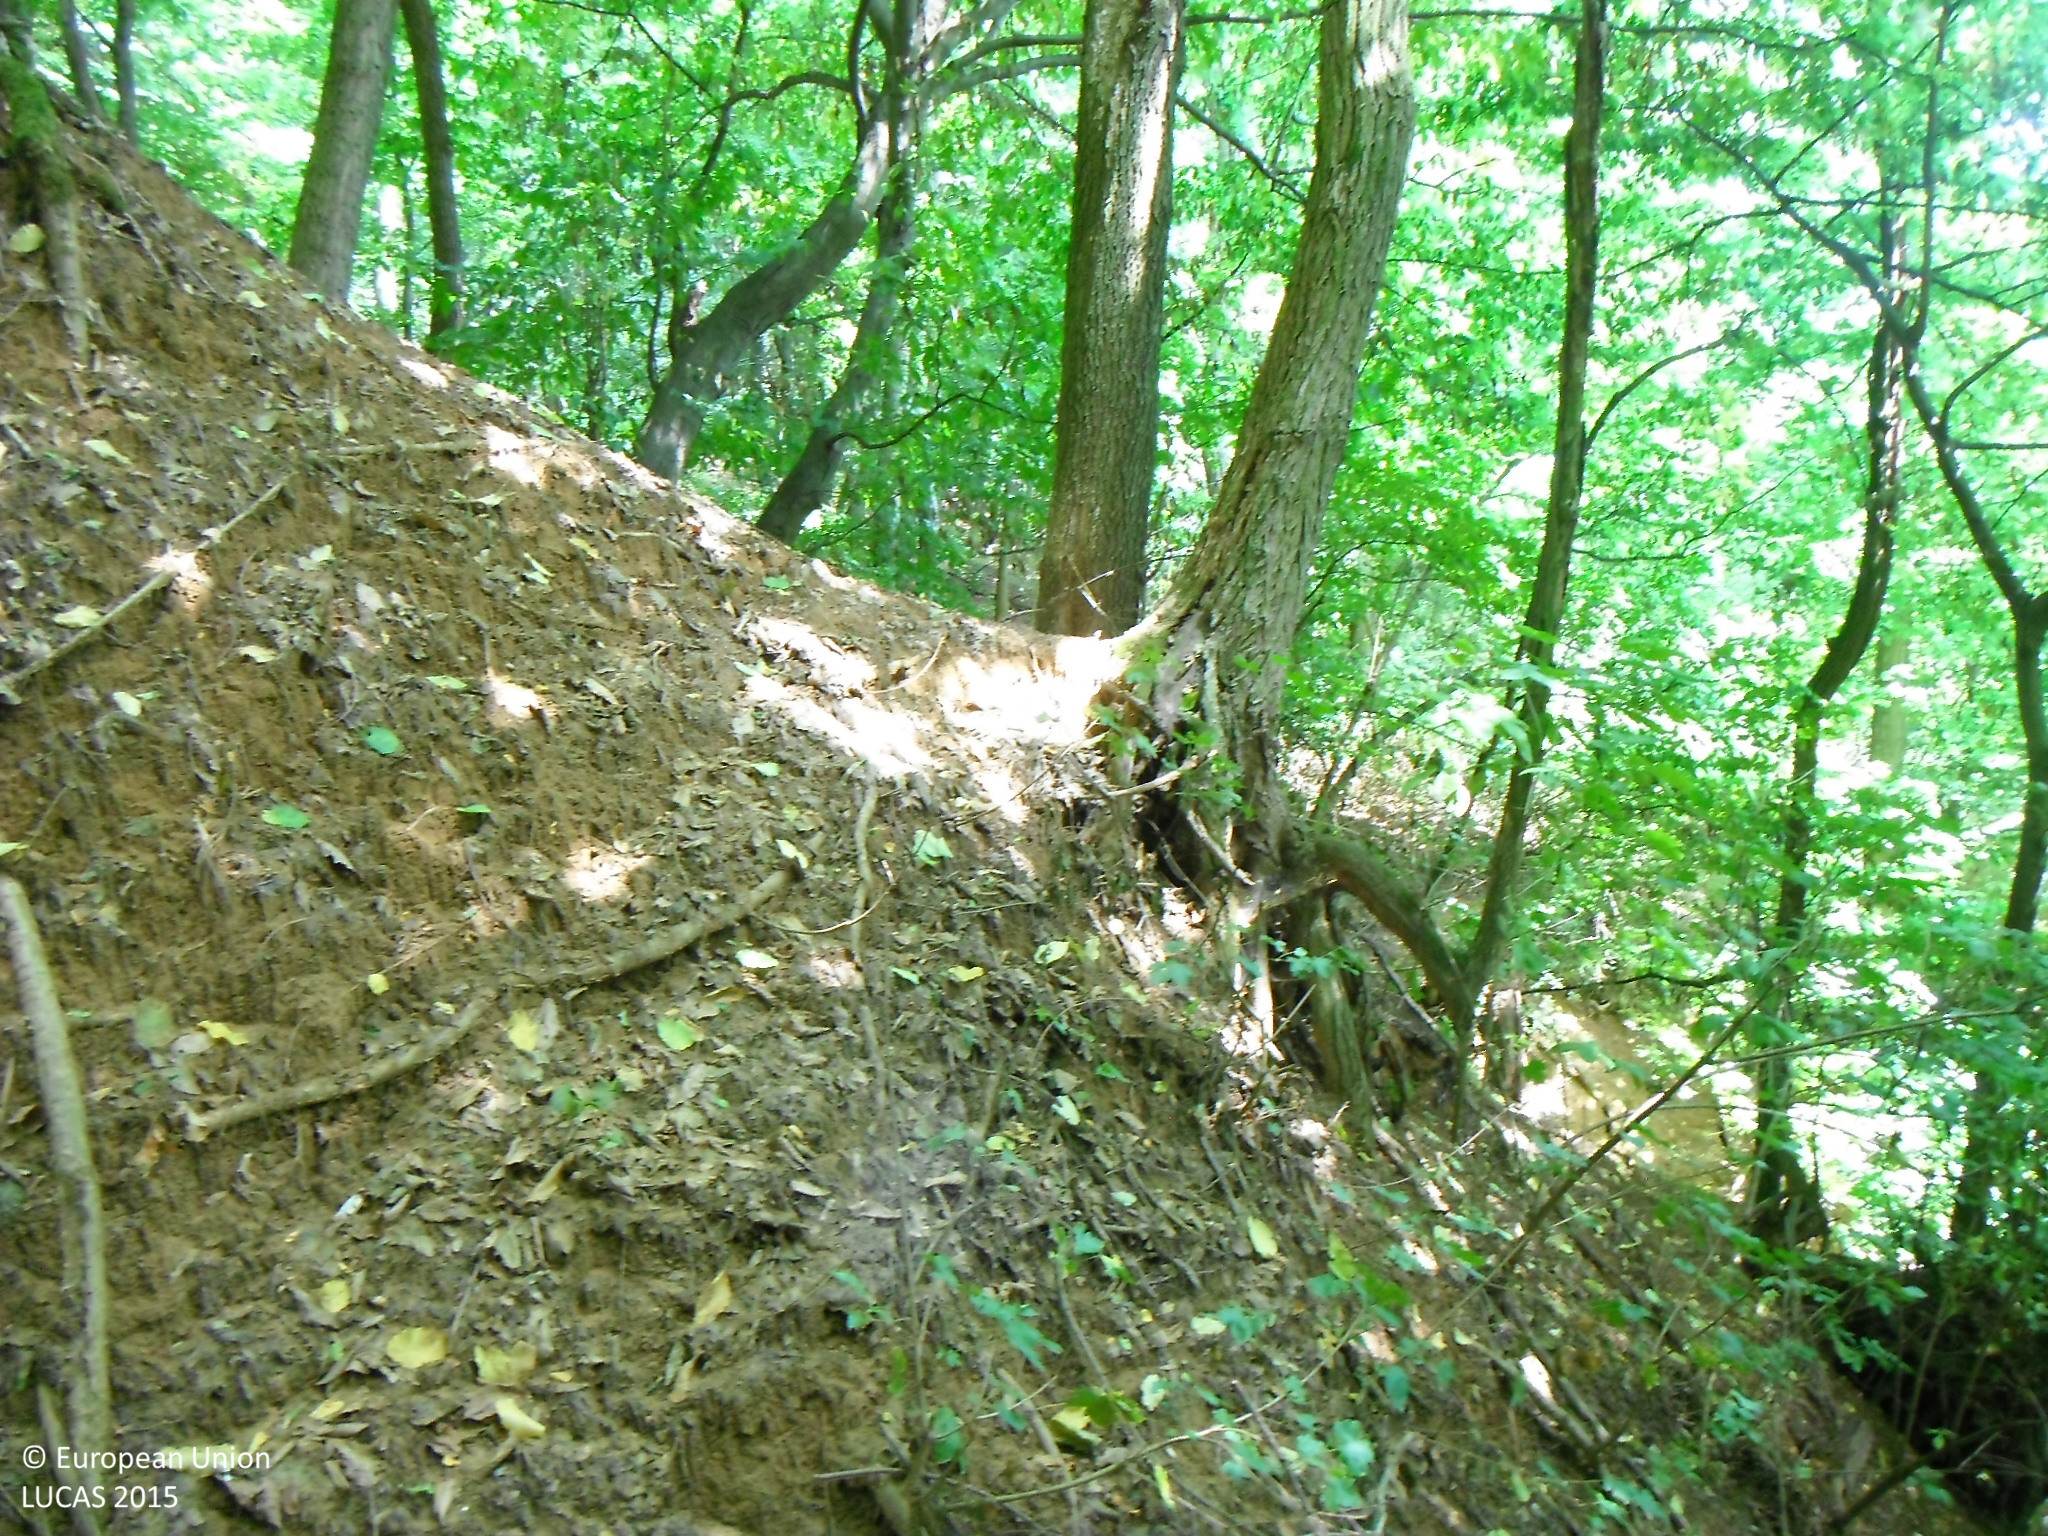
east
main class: Woodland
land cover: Broadleaved woodland
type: exotic forest
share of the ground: > 75 %
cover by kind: broadleaved forest trees 100 %
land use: Forestry
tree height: > 5 m
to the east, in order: Broadleaved woodland; Pine dominated coniferous woodland; Broadleaved woodland
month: July
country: SK
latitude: 48.2054
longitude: 19.9723
